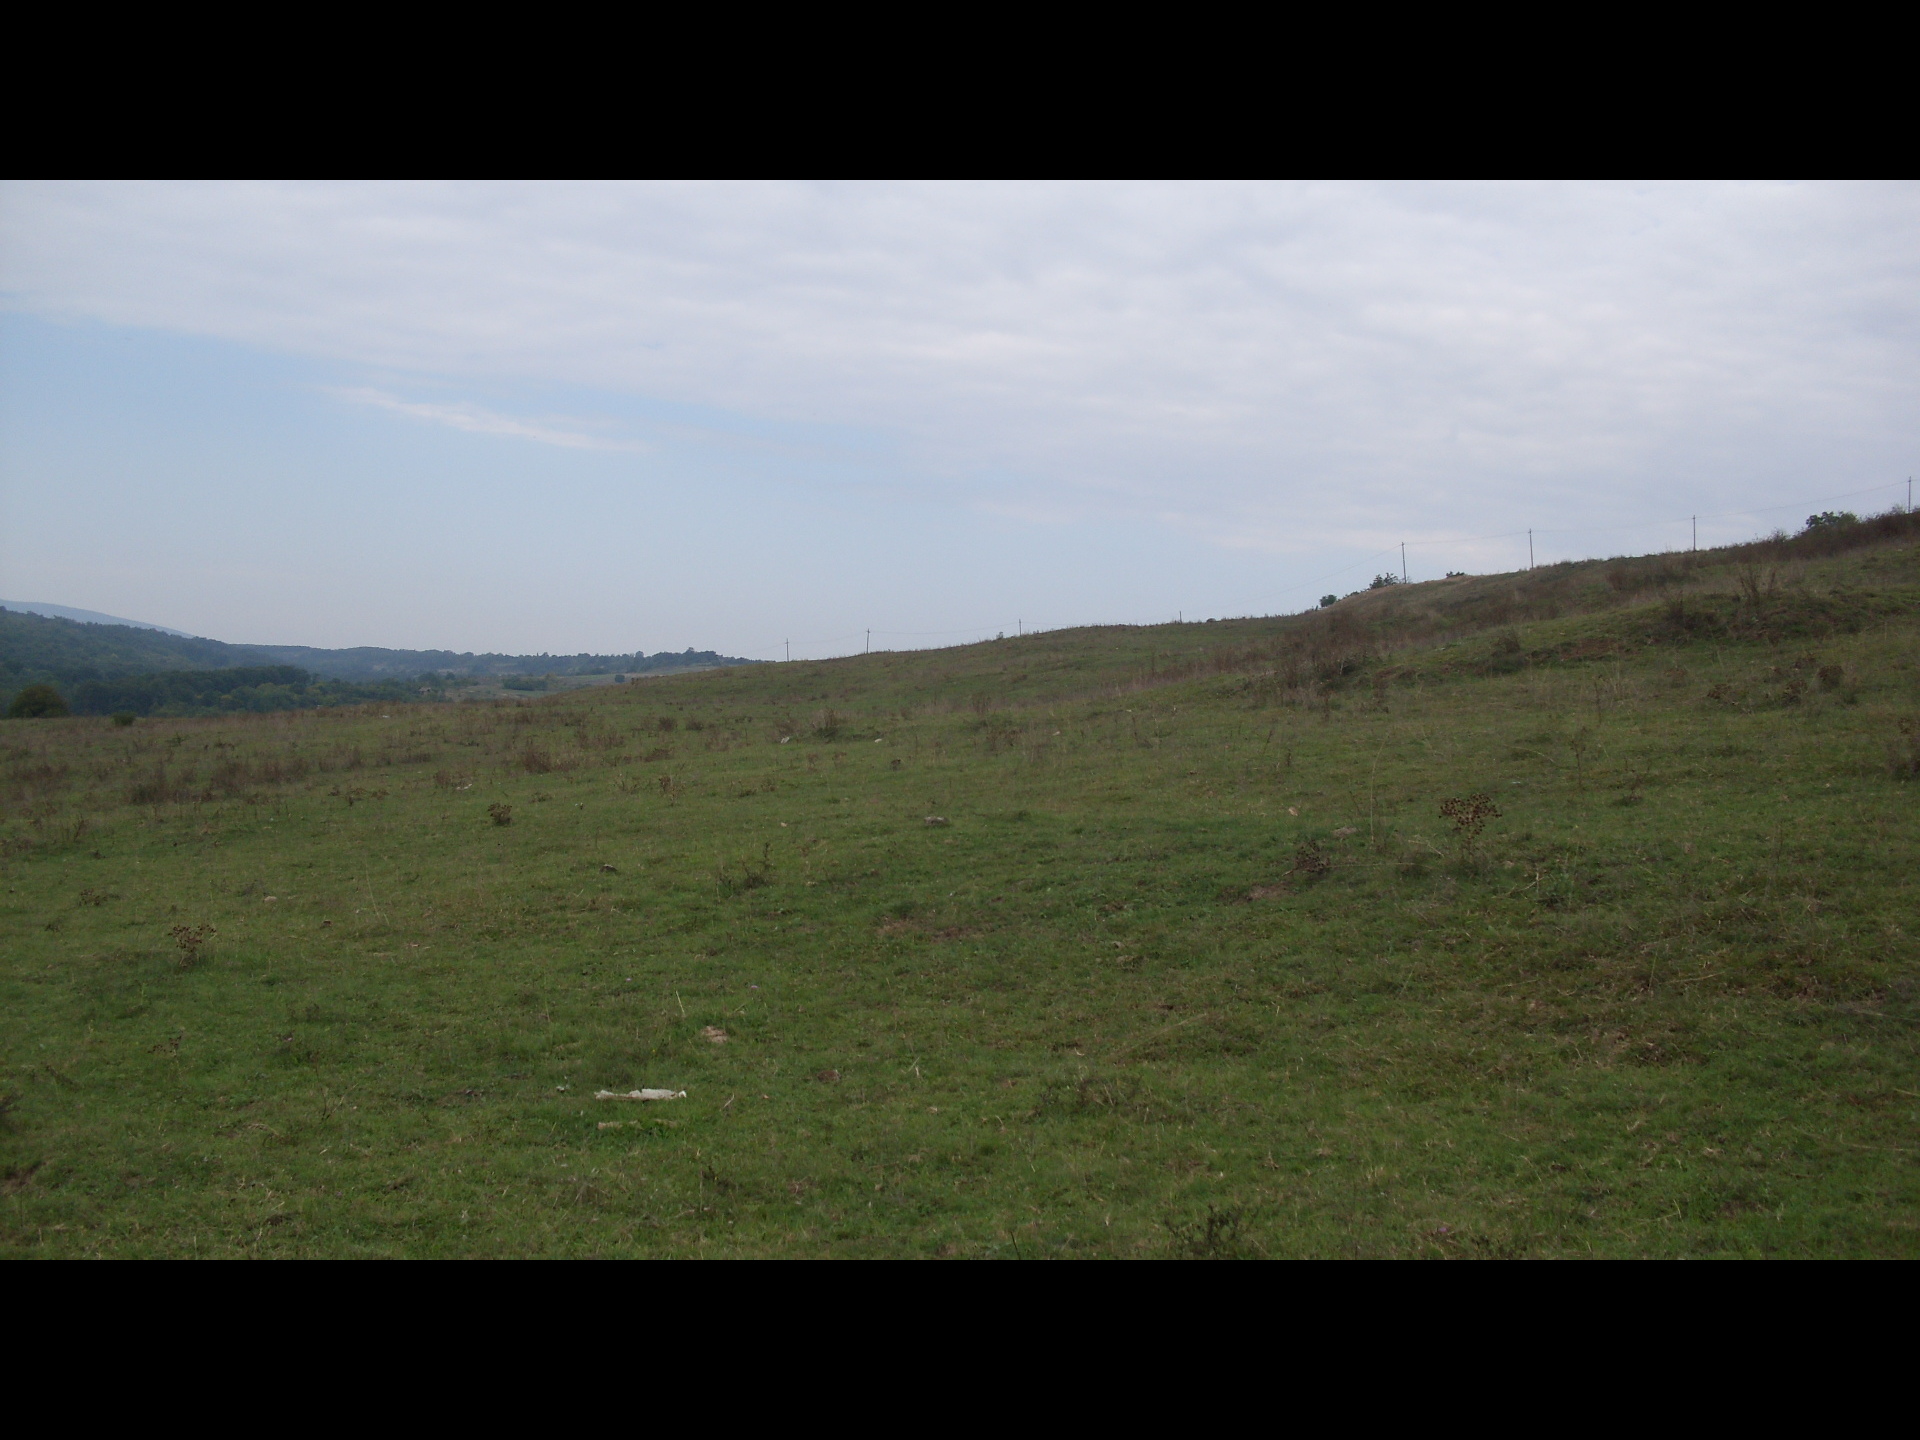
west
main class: Grassland
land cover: Grassland without tree/shrub cover
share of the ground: > 75 %
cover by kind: herbaceous plants 100 %
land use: Agriculture (excluding fallow land and kitchen gardens)
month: October
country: BG
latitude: 43.8811
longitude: 22.5171
